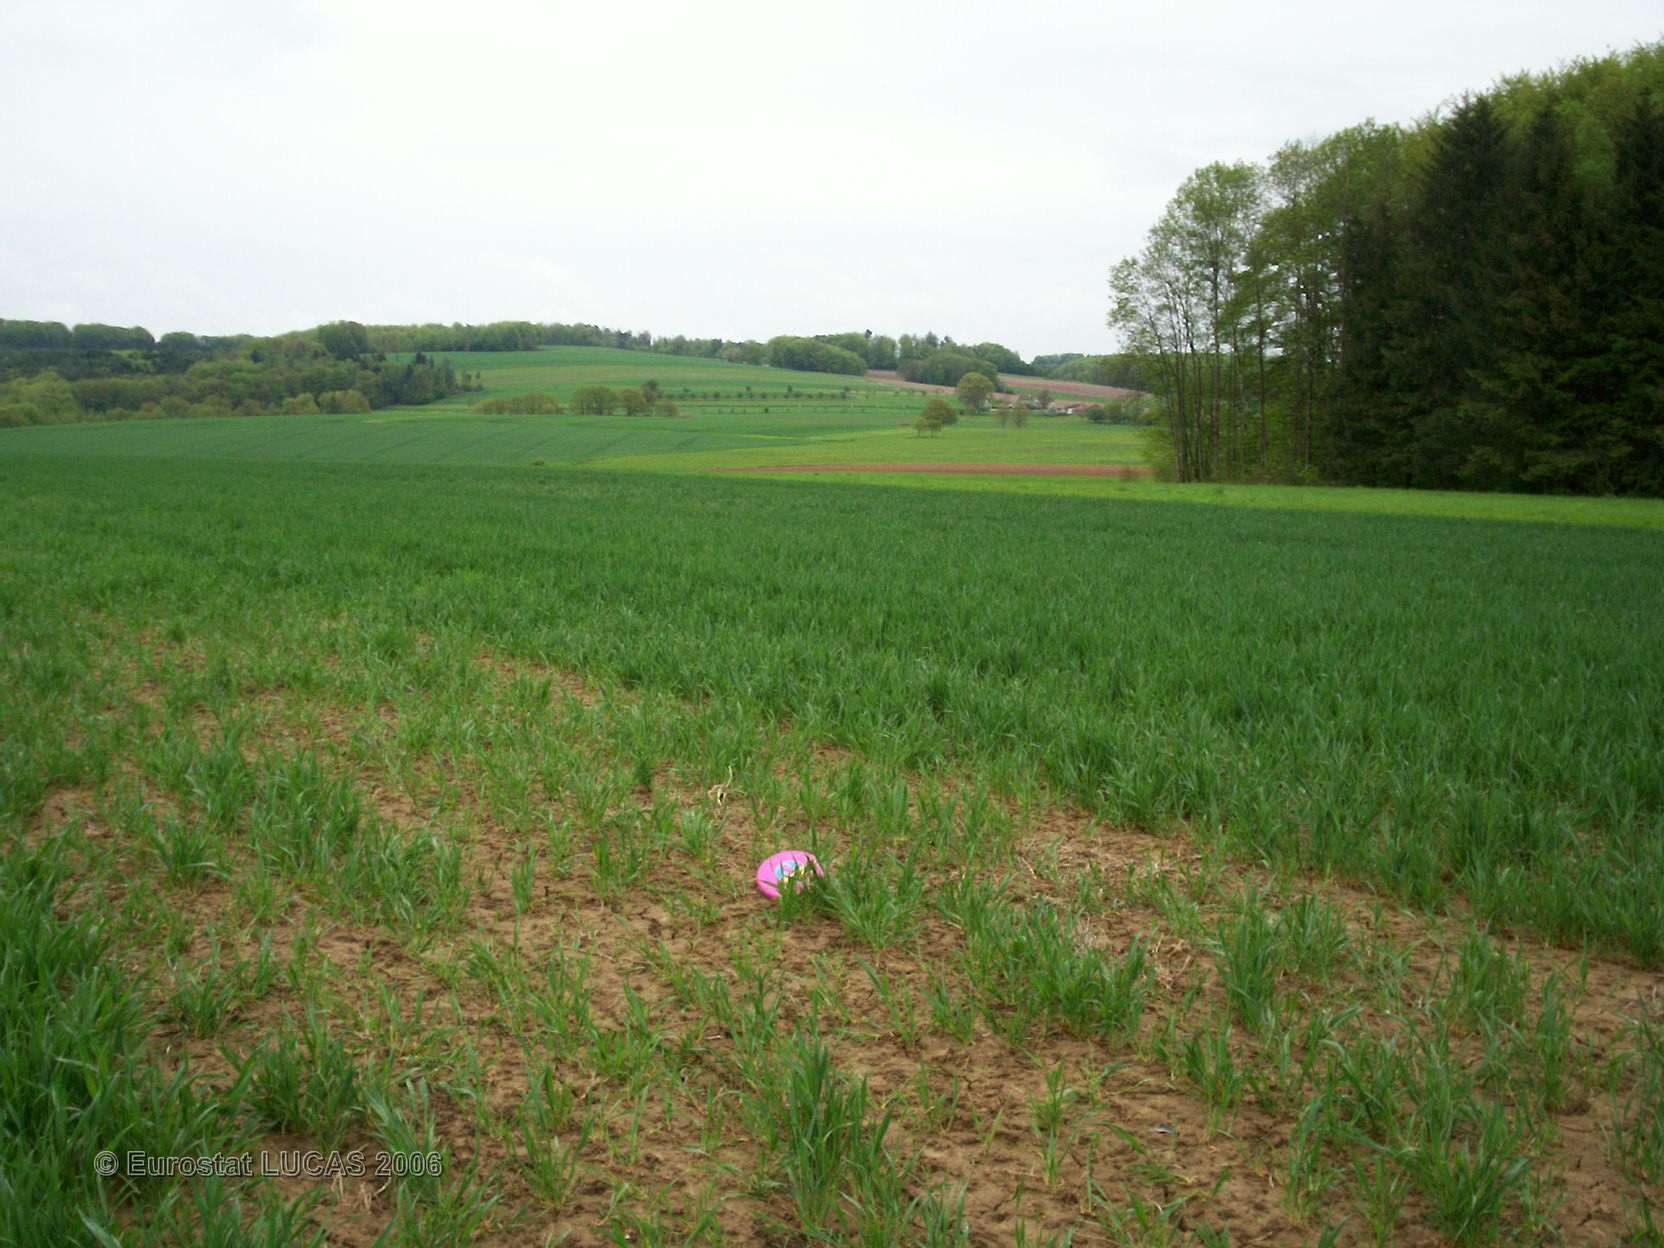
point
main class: Cropland
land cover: Common wheat
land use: Agriculture (excluding fallow land and kitchen gardens)
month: May
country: FR
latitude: 48.1086
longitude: 6.3341
